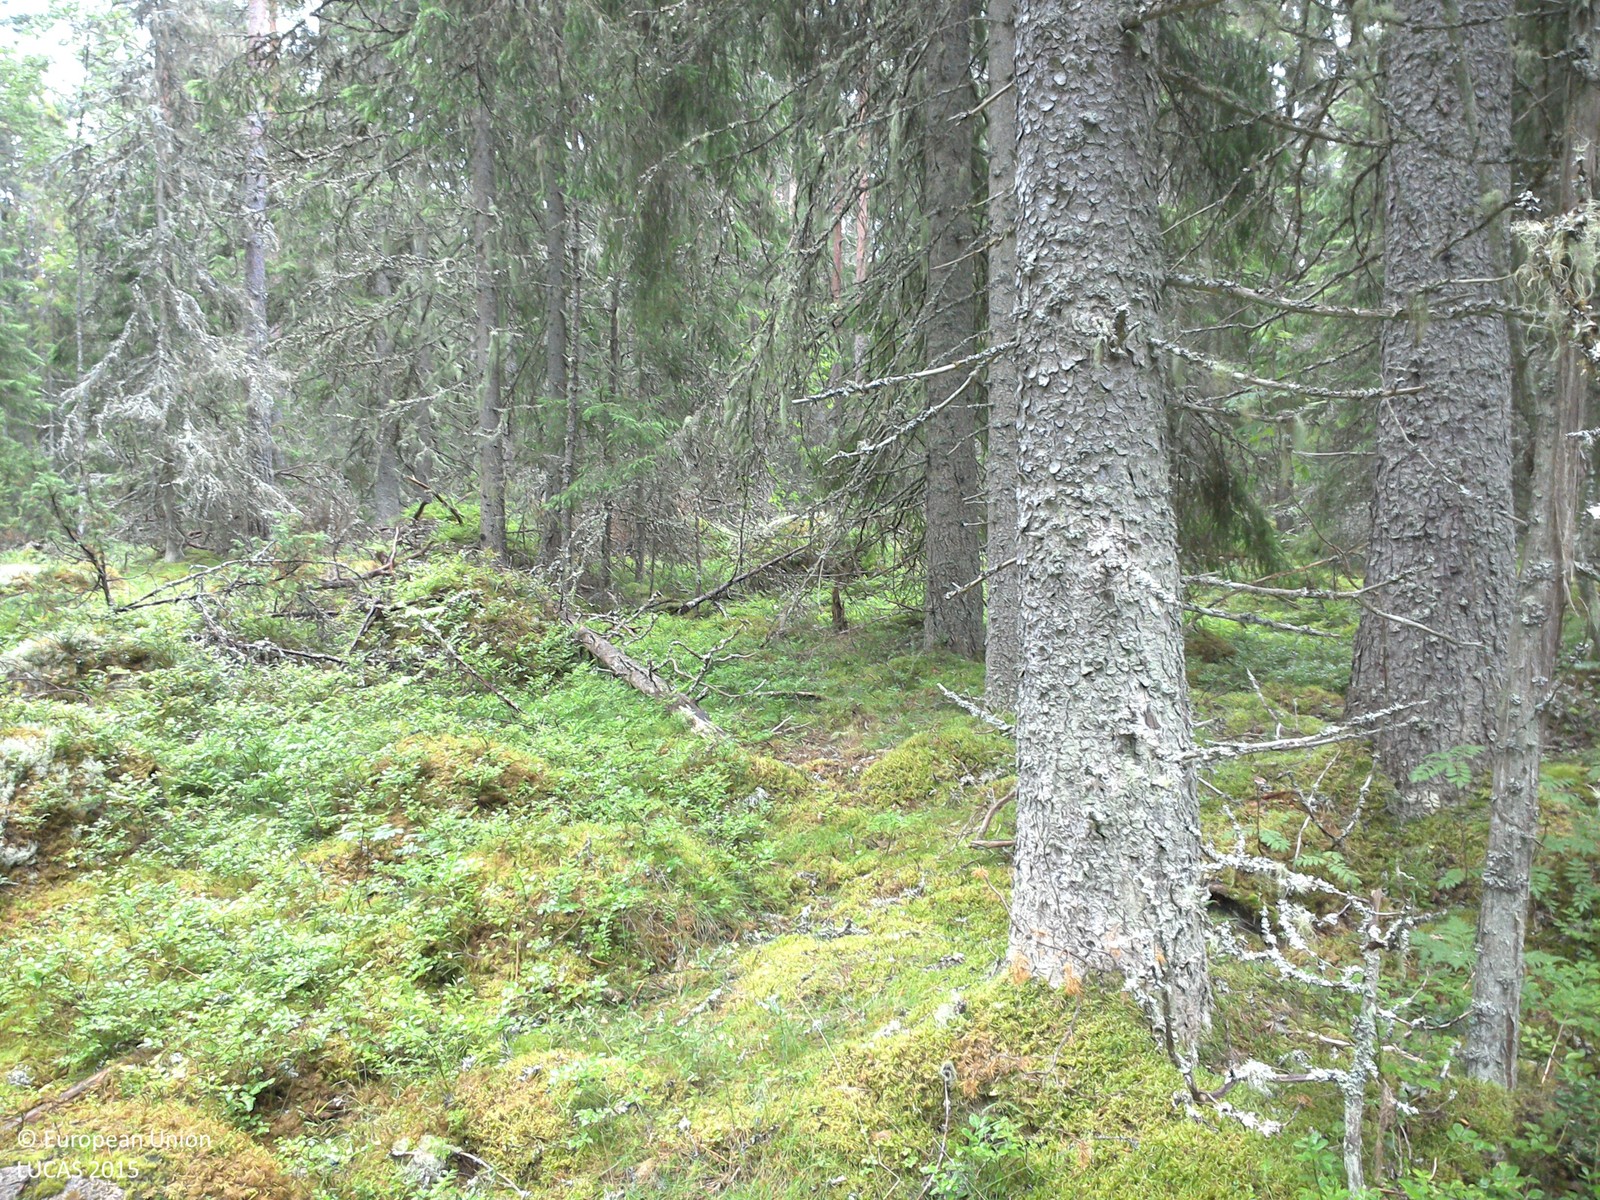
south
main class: Woodland
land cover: Spruce dominated coniferous woodland
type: boreal forest
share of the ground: > 75 %
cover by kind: coniferous forest trees 75 %, lichens and mosses 20 %, herbaceous plants 5 %
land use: Forestry
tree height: > 5 m
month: July
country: SE
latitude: 57.7654
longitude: 15.8970
